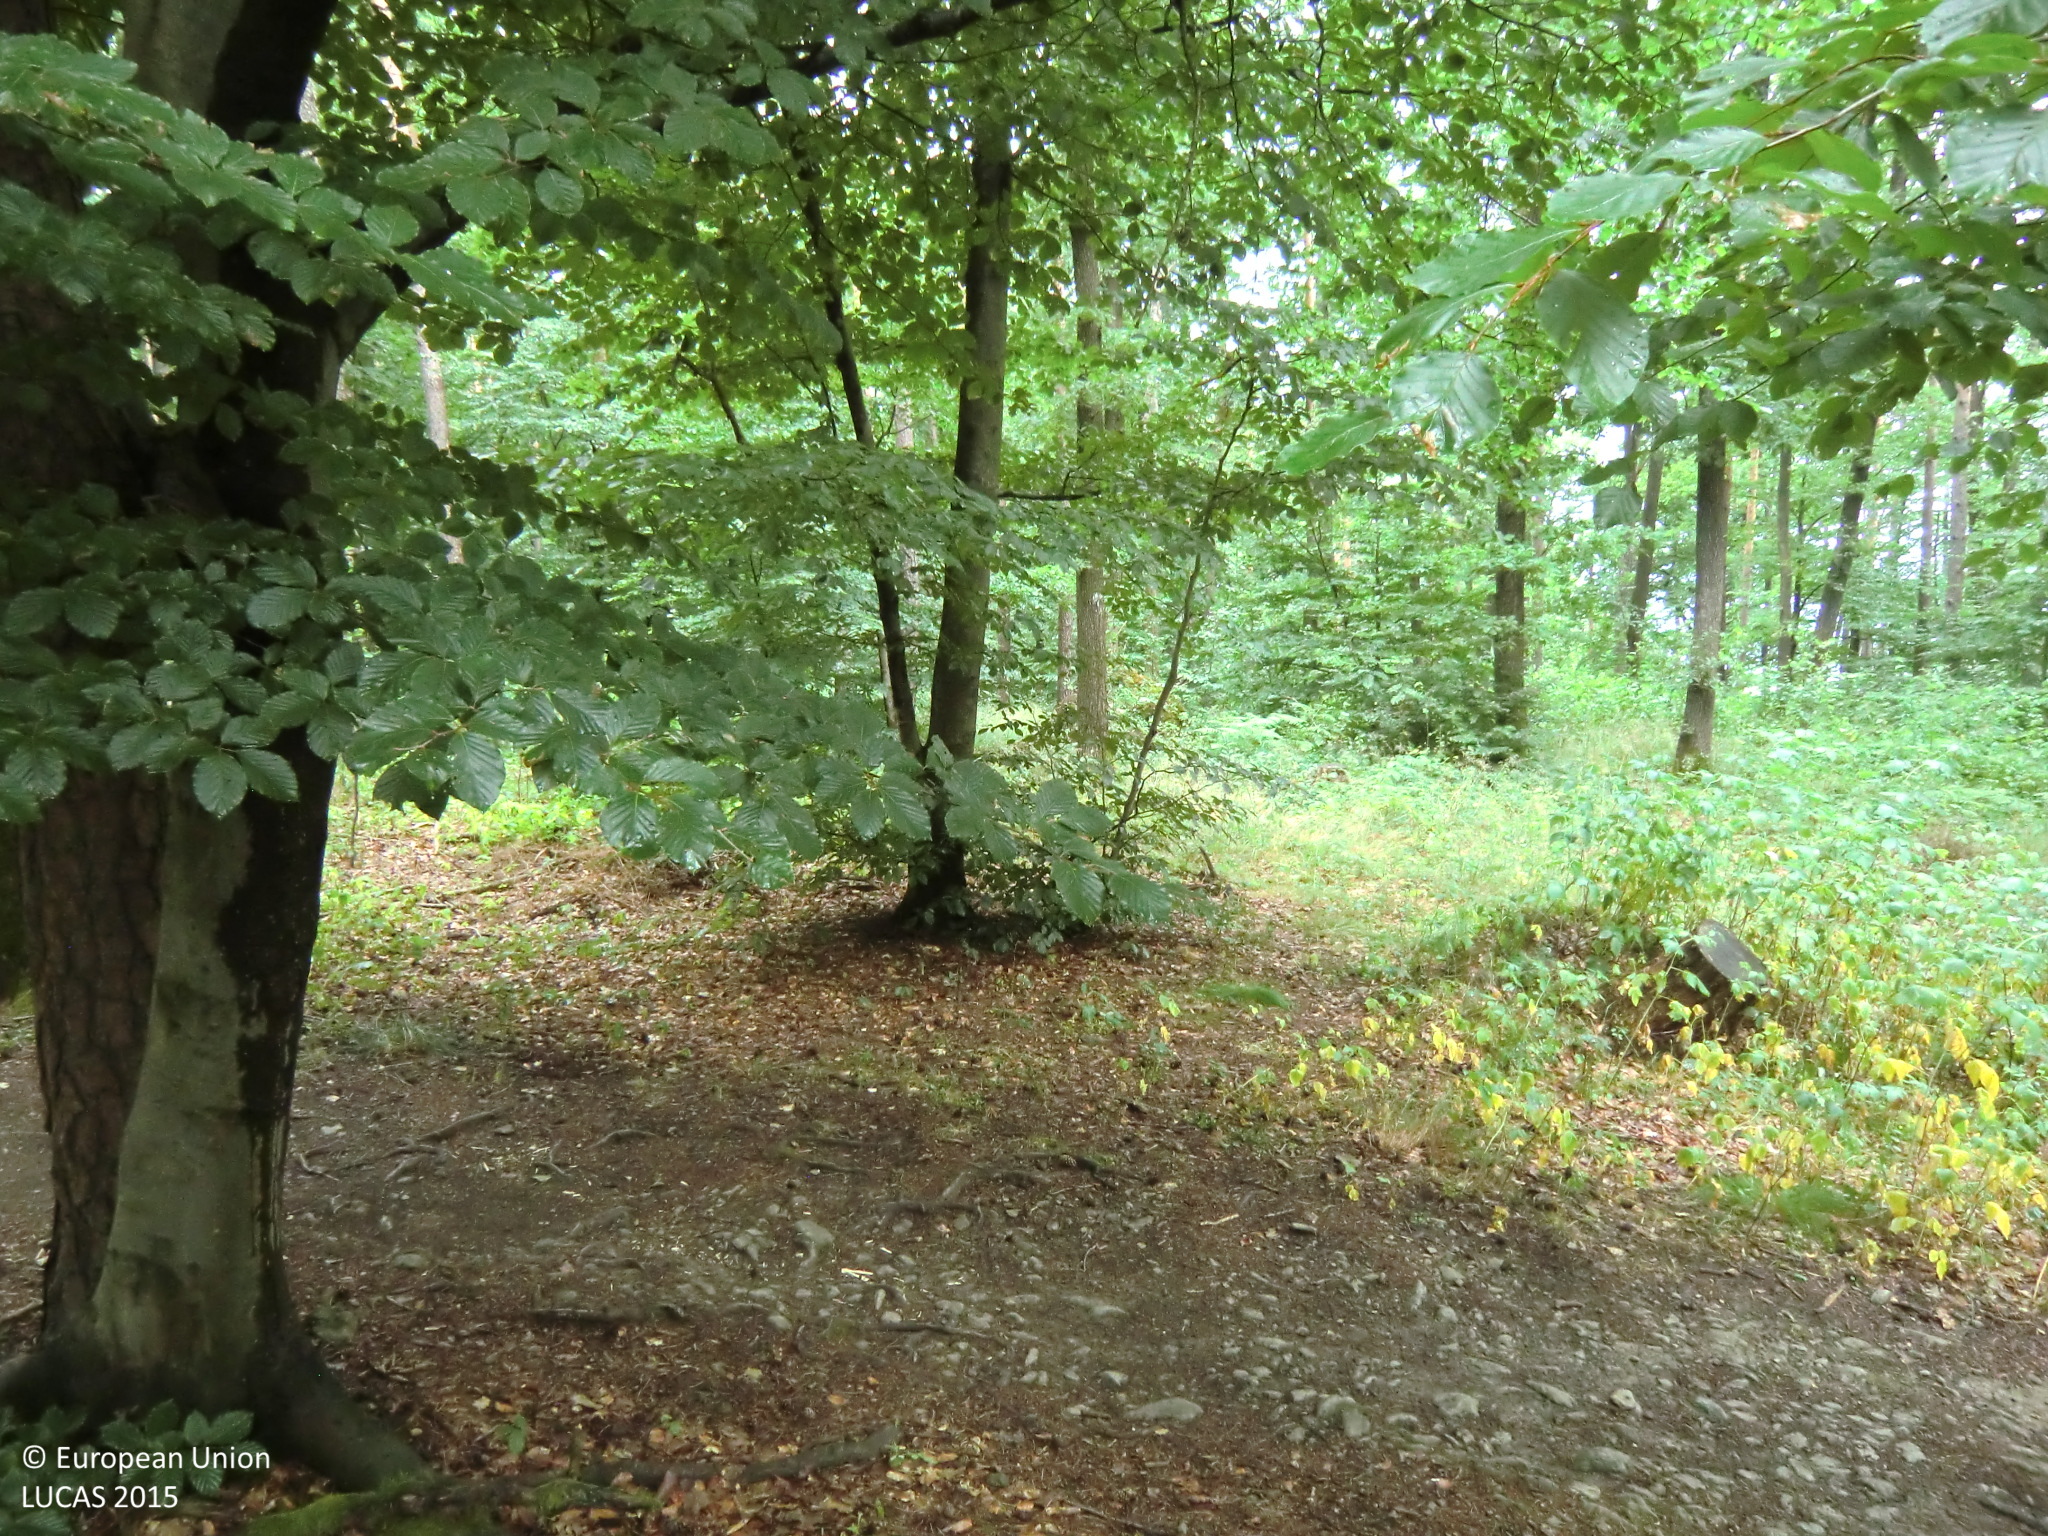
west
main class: Woodland
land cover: Pine dominated mixed woodland
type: hemiboreal forest and nemoral coniferous forest and mixed broadleaved-coniferous forest
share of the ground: 50 - 75 %
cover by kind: broadleaved forest trees 40 %, coniferous forest trees 30 %, shrubs 20 %, unconsolidated bare surface 10 %
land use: Forestry
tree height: > 5 m
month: July
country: AT
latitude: 47.1137
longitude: 15.4693
